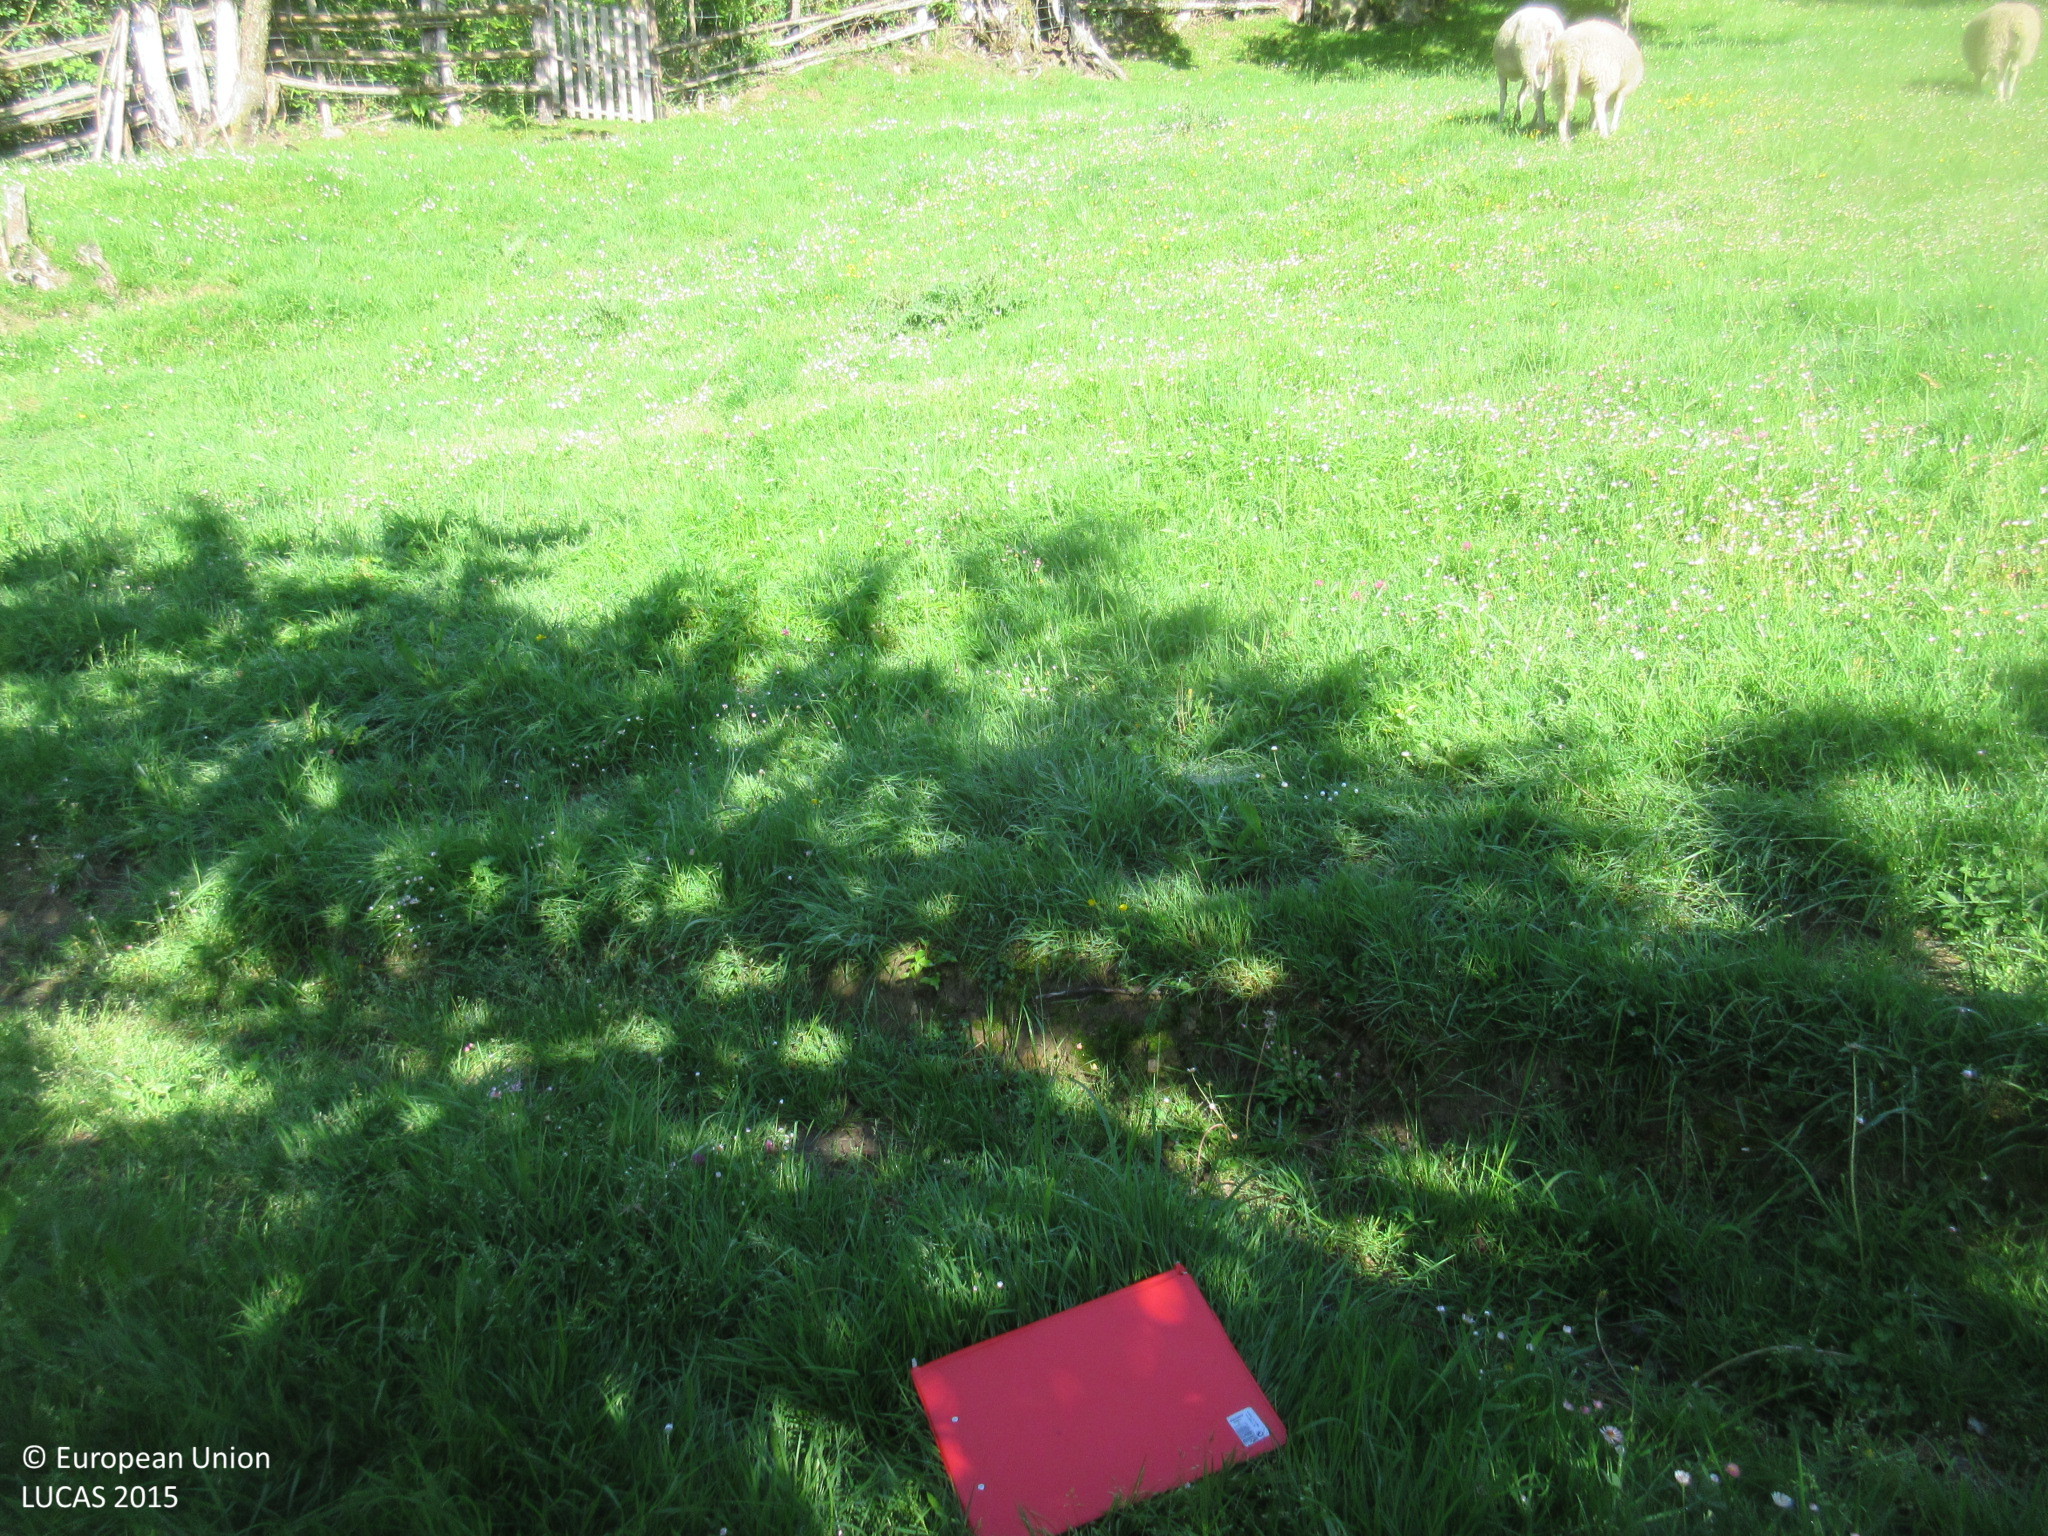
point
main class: Grassland
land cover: Grassland without tree/shrub cover
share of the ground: > 75 %
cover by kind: herbaceous plants 100 %
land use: Agriculture (excluding fallow land and kitchen gardens)
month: May
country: ES
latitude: 43.2768
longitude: -5.5696
